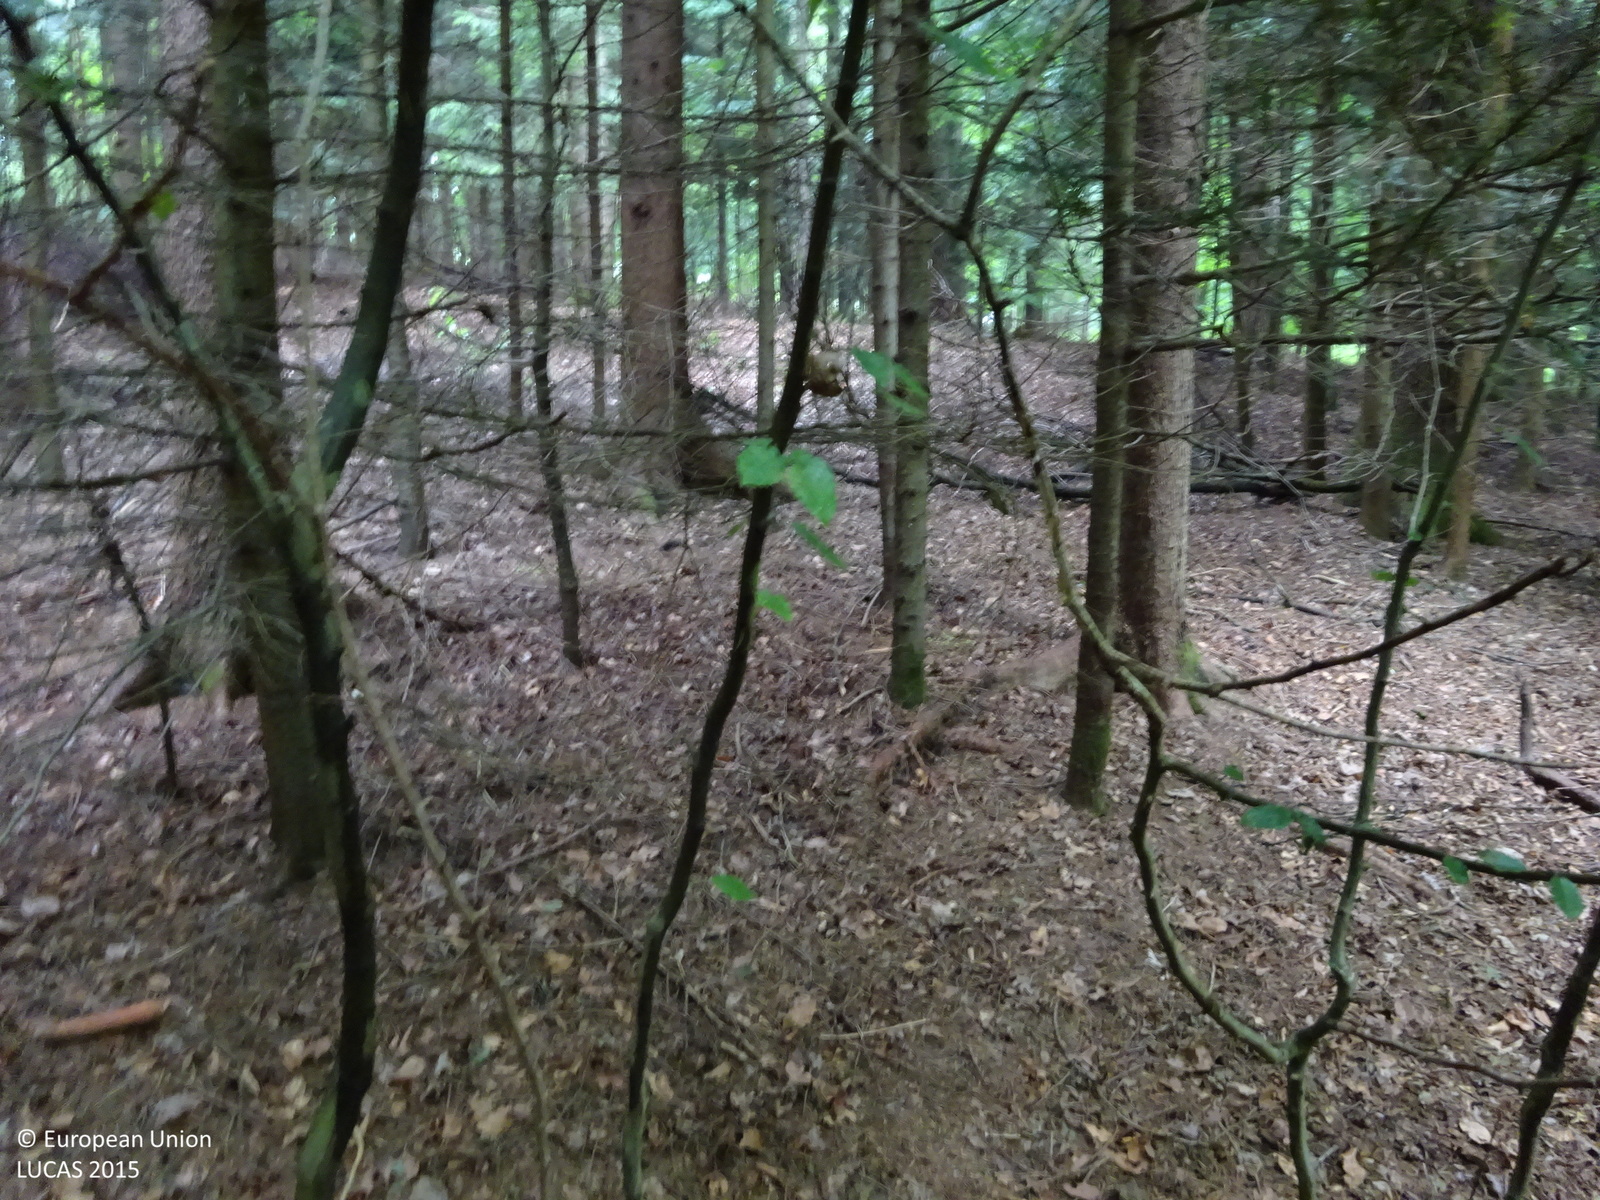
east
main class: Woodland
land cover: Spruce dominated mixed woodland
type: mountainous beech forest
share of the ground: > 75 %
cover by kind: coniferous forest trees 40 %, broadleaved forest trees 40 %, shrubs 20 %
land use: Forestry
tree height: > 5 m
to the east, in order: Spruce dominated mixed woodland; Spruce dominated coniferous woodland; Spruce dominated mixed woodland; Broadleaved woodland; Grassland with sparse tree/shrub cover; Ditches and canals; Paved roads, cycling and walking lanes; Grass margins; Broadleaved woodland; Spruce dominated mixed woodland
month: July
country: AT
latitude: 46.8343
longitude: 15.2827
